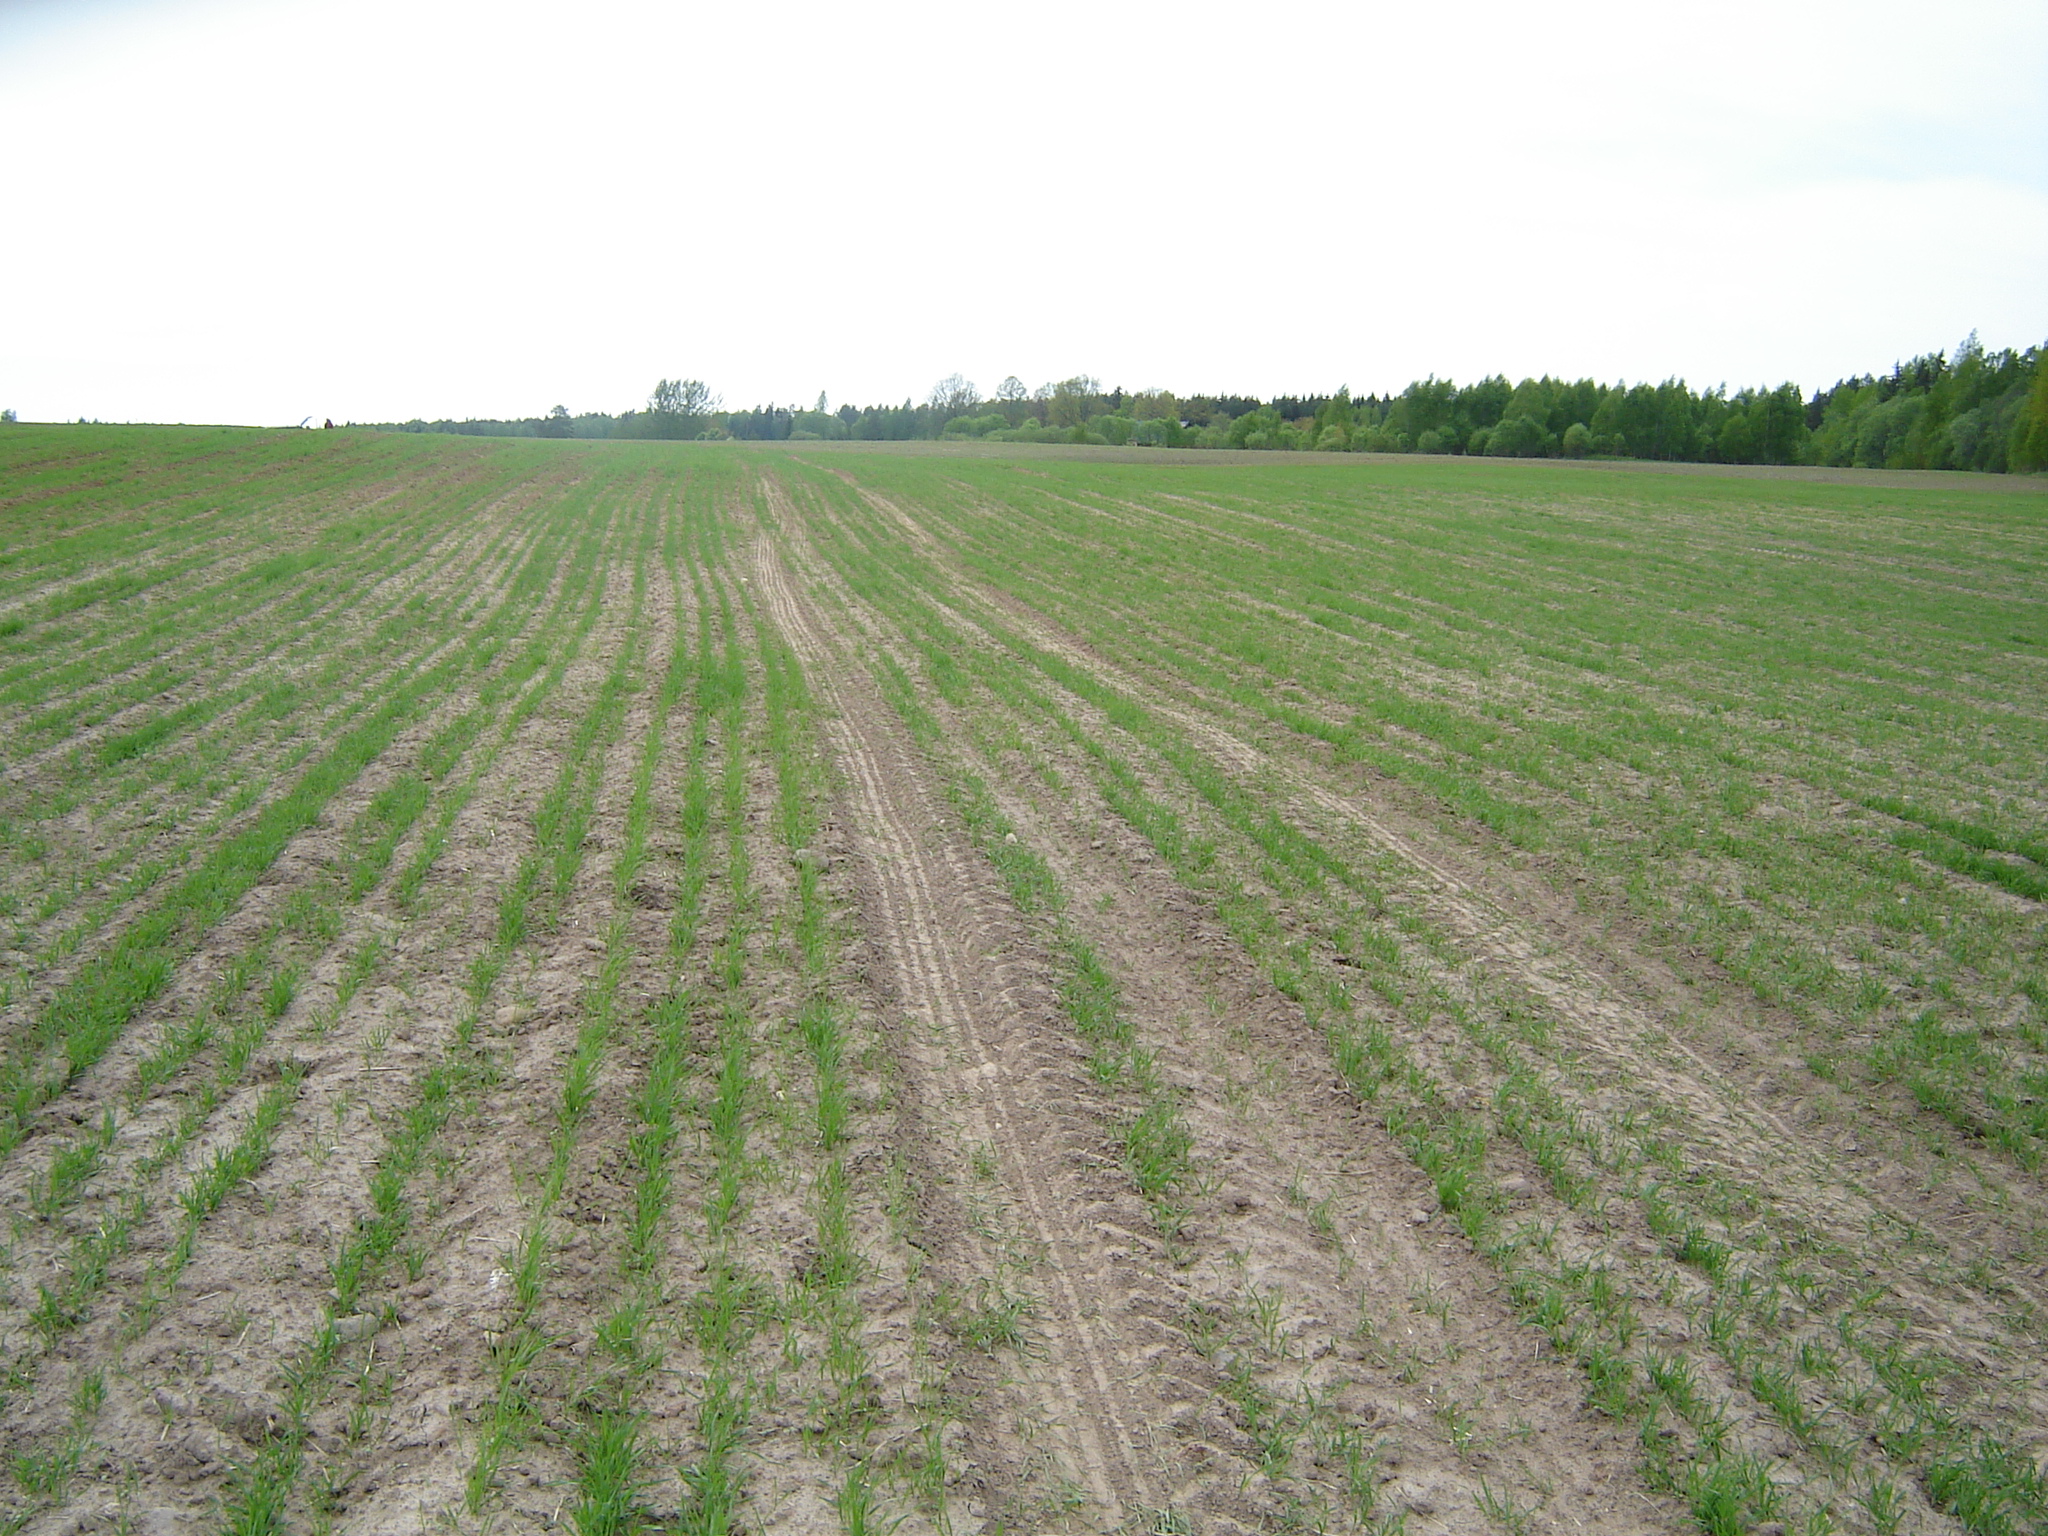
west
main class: Cropland
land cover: Common wheat
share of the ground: 25 - 50 %
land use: Agriculture (excluding fallow land and kitchen gardens)
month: May
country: LT
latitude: 55.8622
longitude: 25.6412
